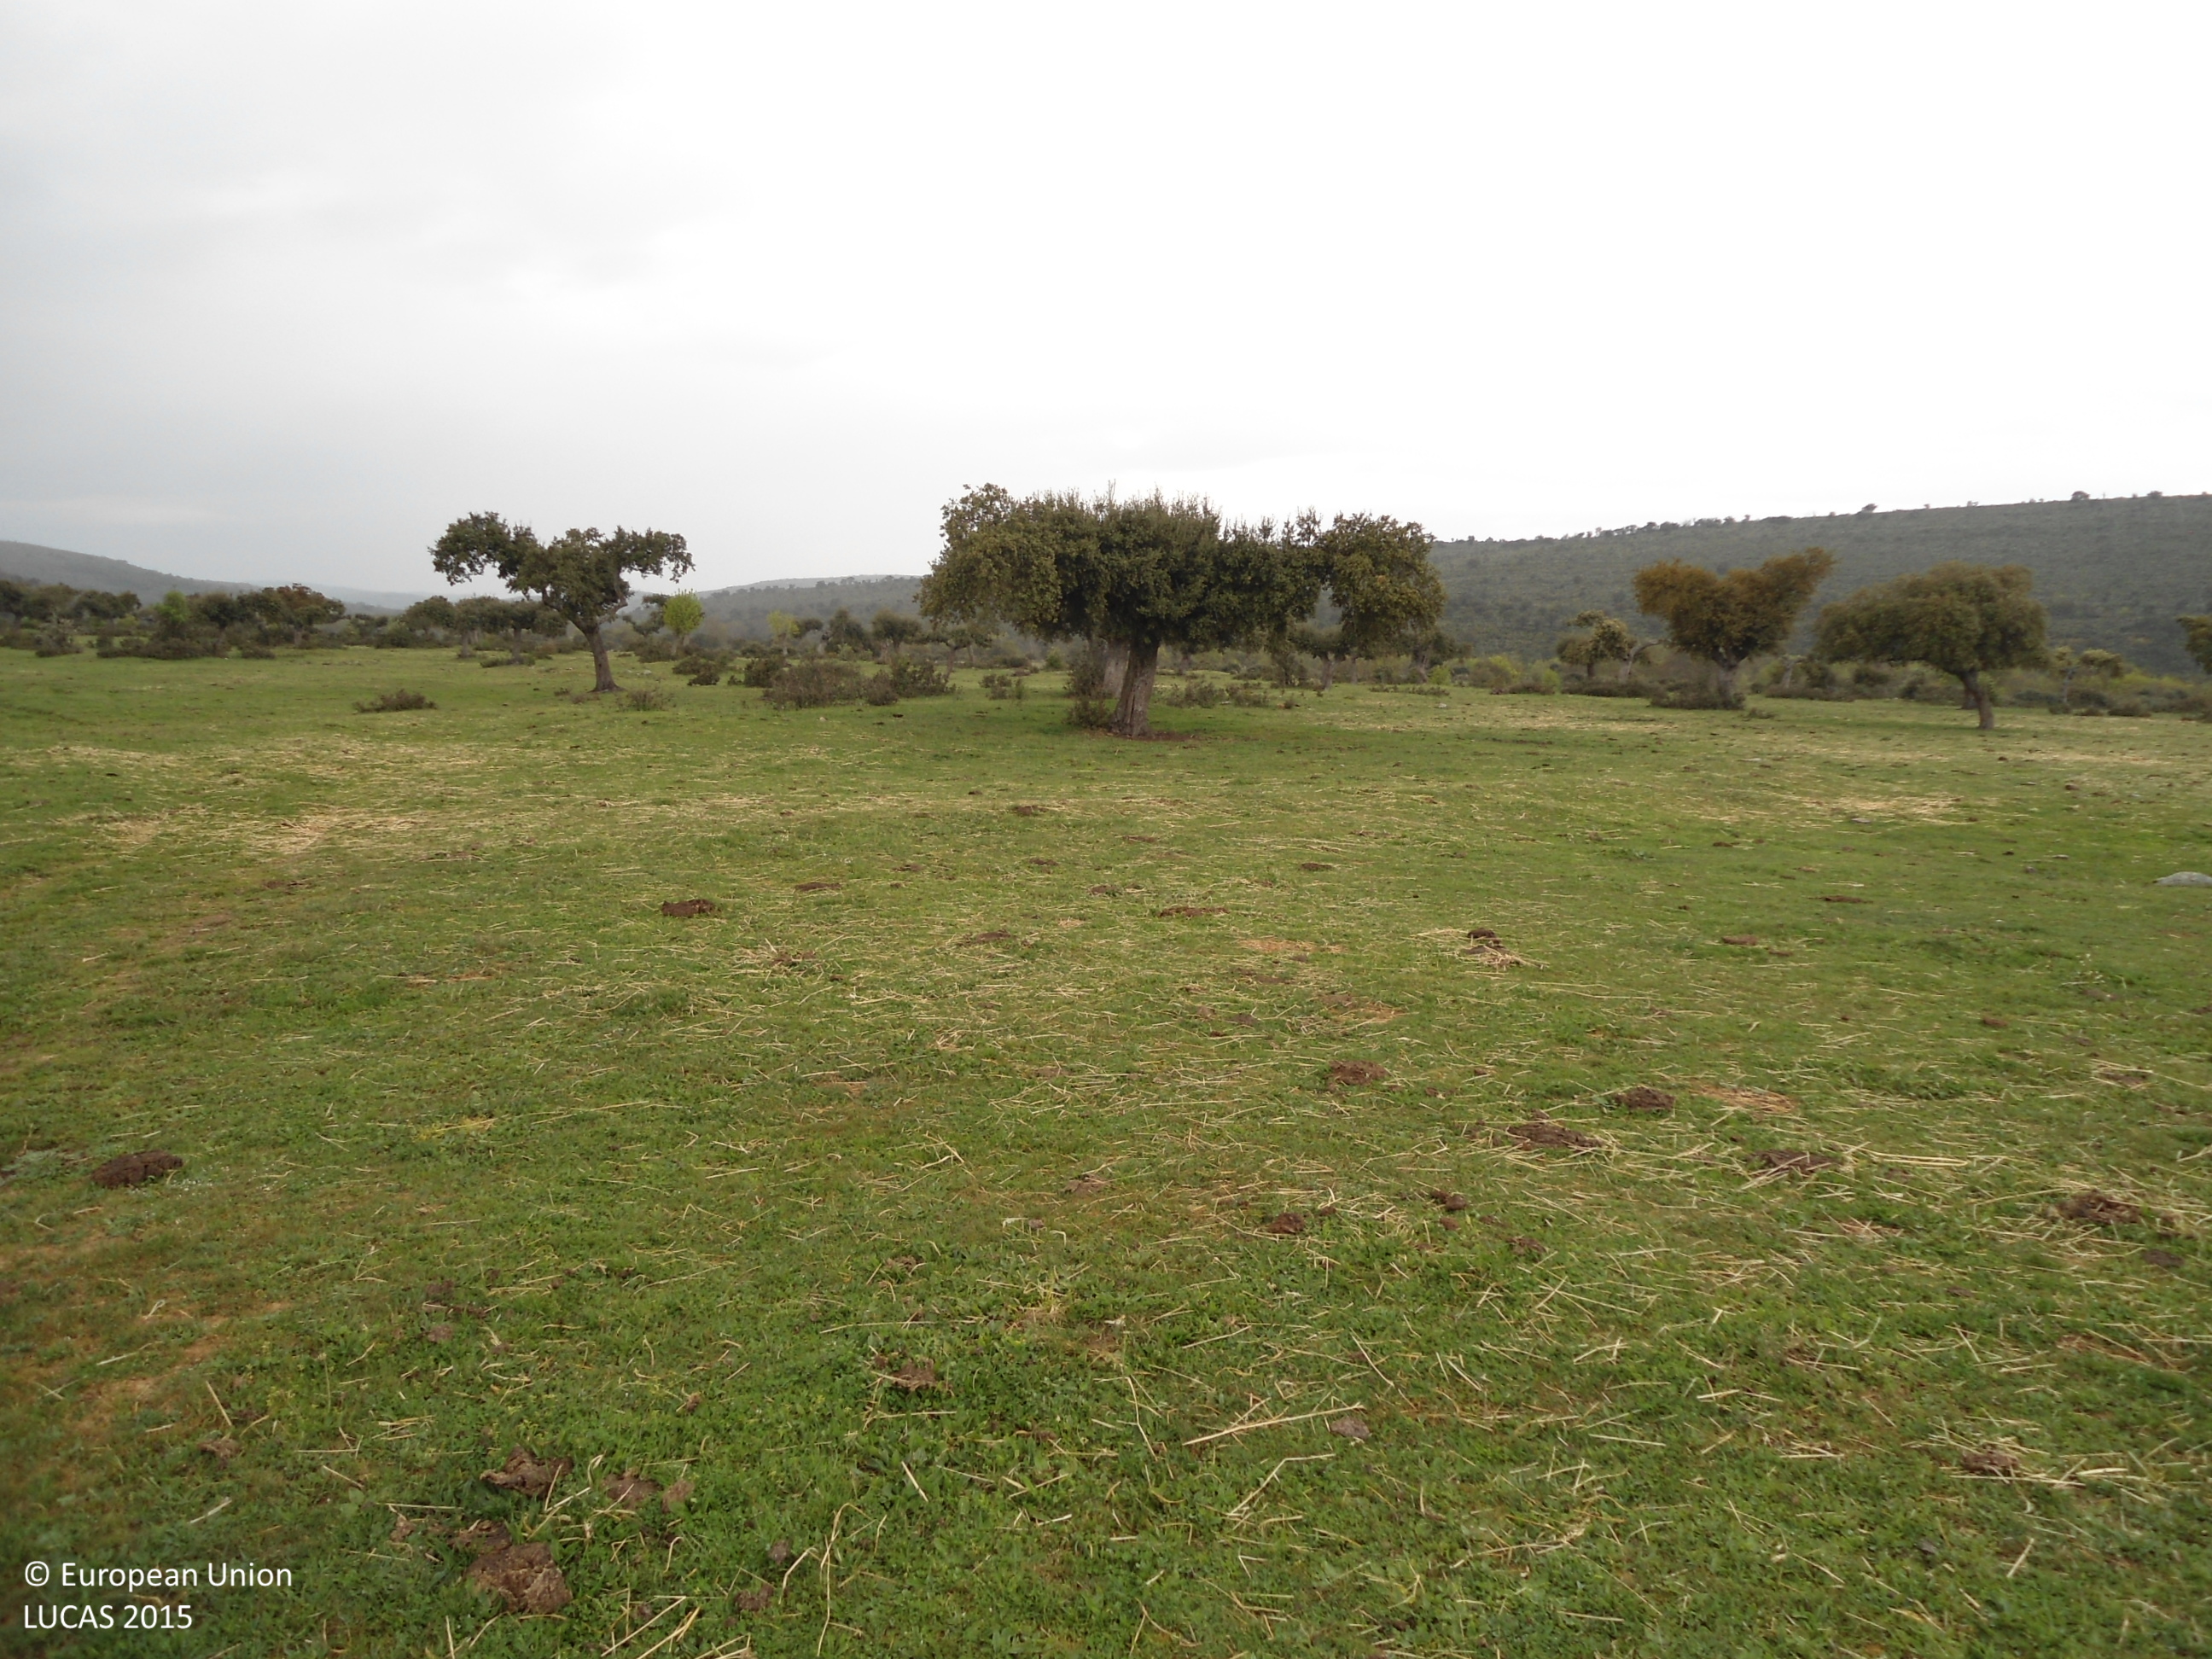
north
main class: Grassland
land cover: Grassland without tree/shrub cover
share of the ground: > 75 %
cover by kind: herbaceous plants 100 %
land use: Agriculture (excluding fallow land and kitchen gardens)
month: April
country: ES
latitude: 41.7510
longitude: -5.9320
